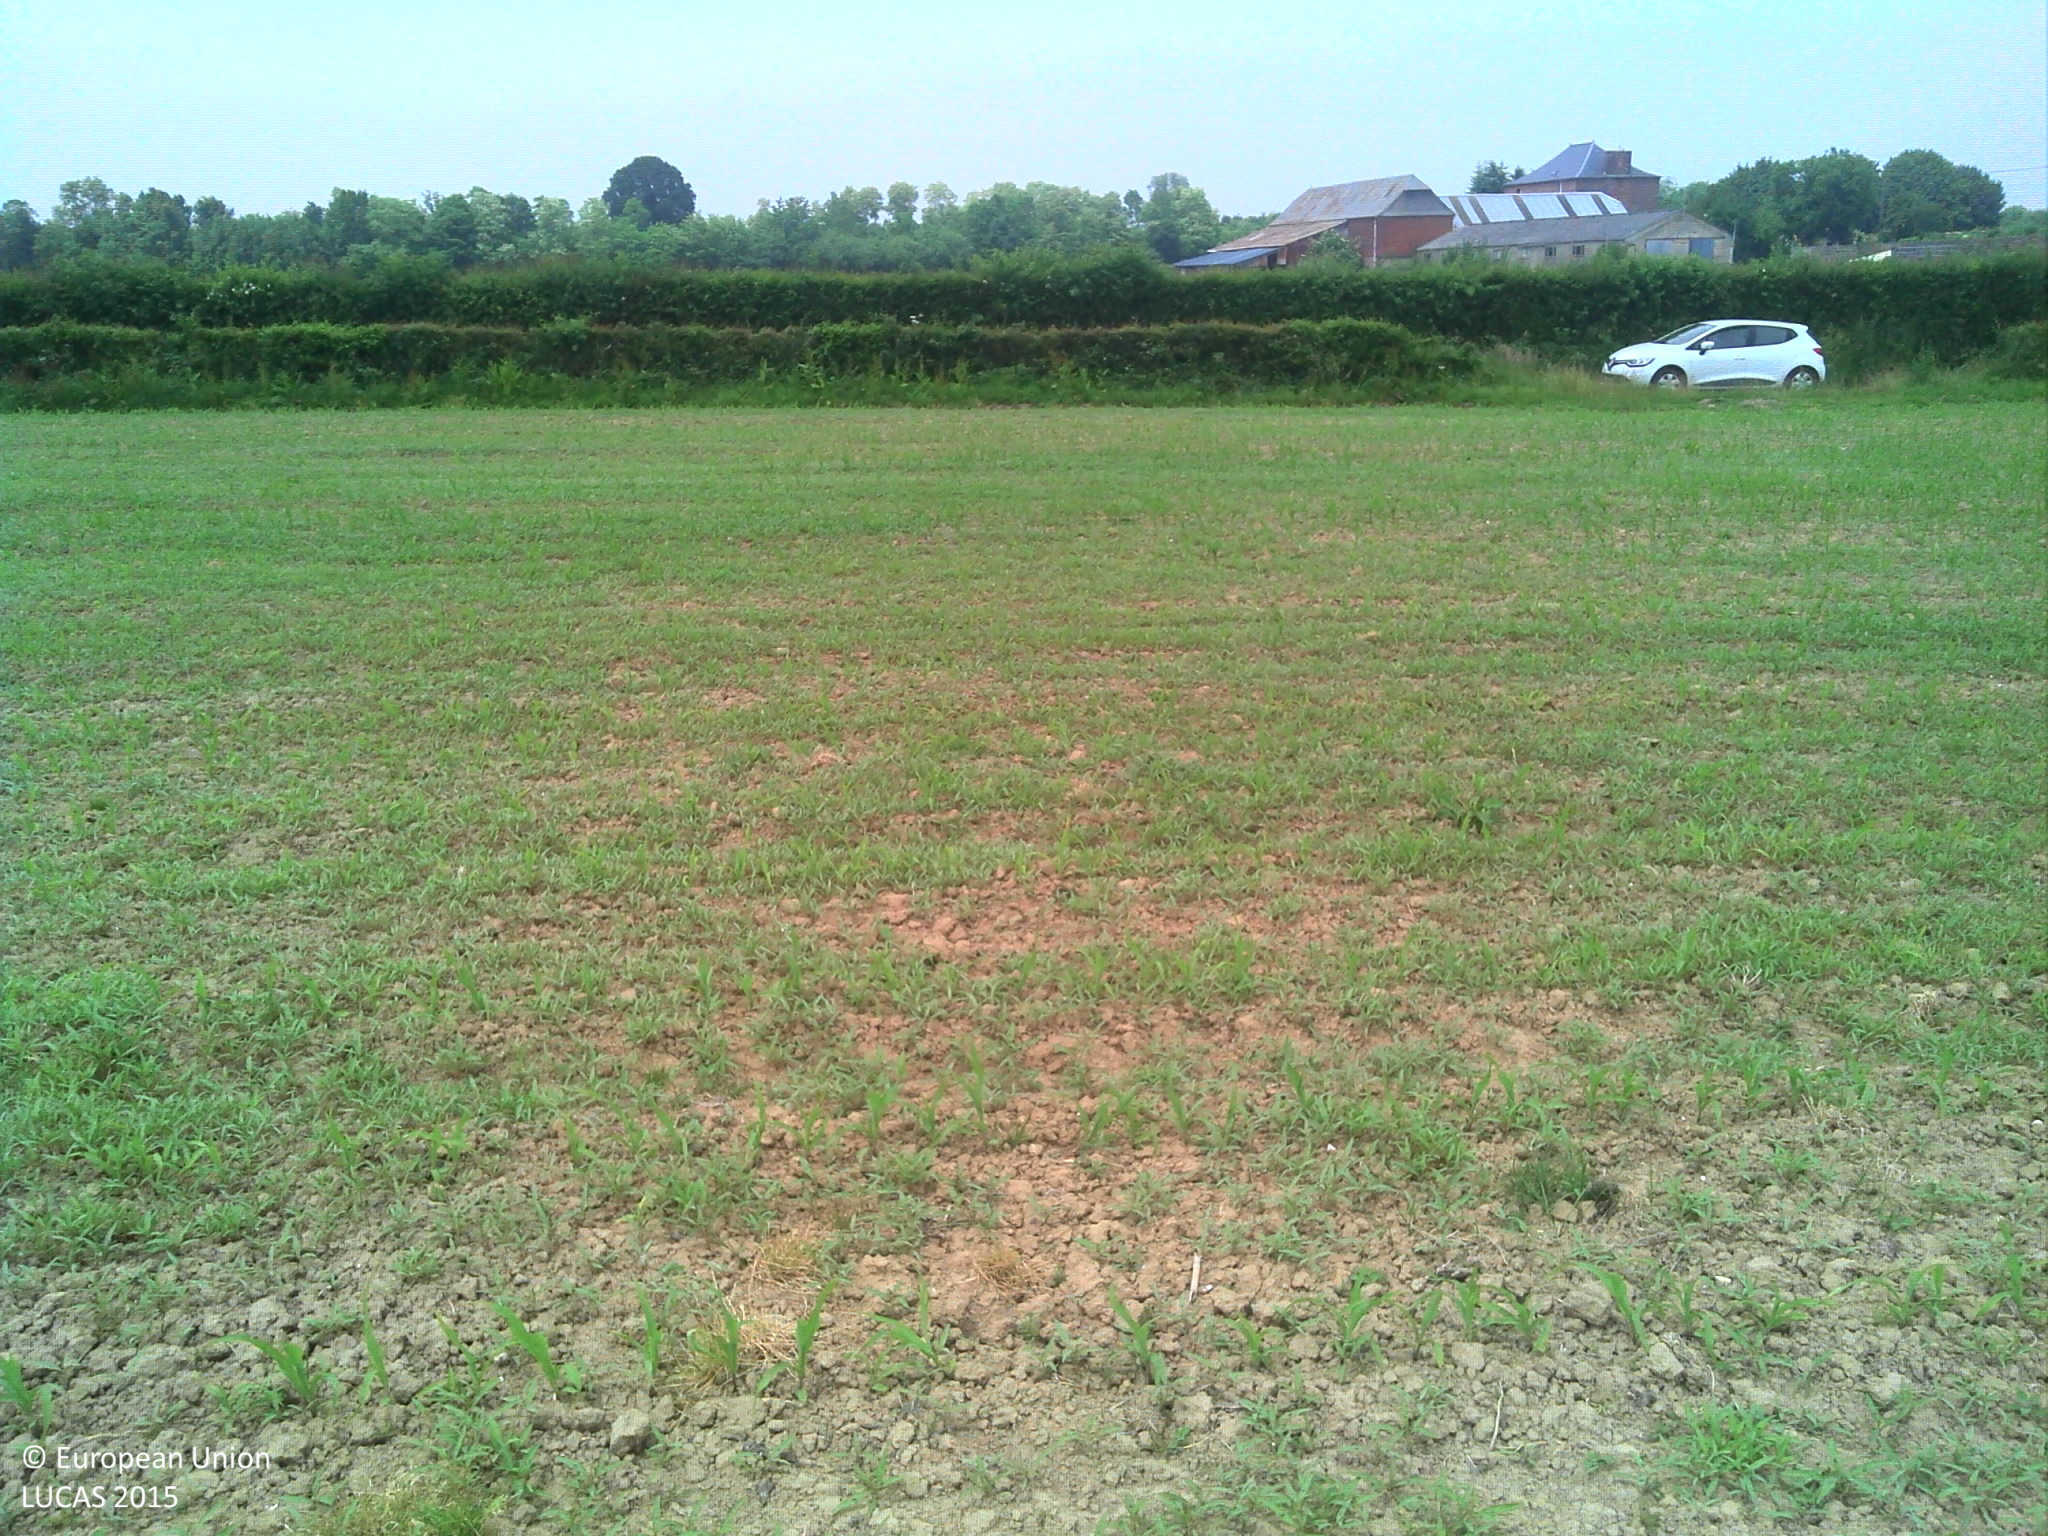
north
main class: Cropland
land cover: Maize
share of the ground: 10 - 25 %
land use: Agriculture (excluding fallow land and kitchen gardens)
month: June
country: FR
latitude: 49.9534
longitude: 3.9873
